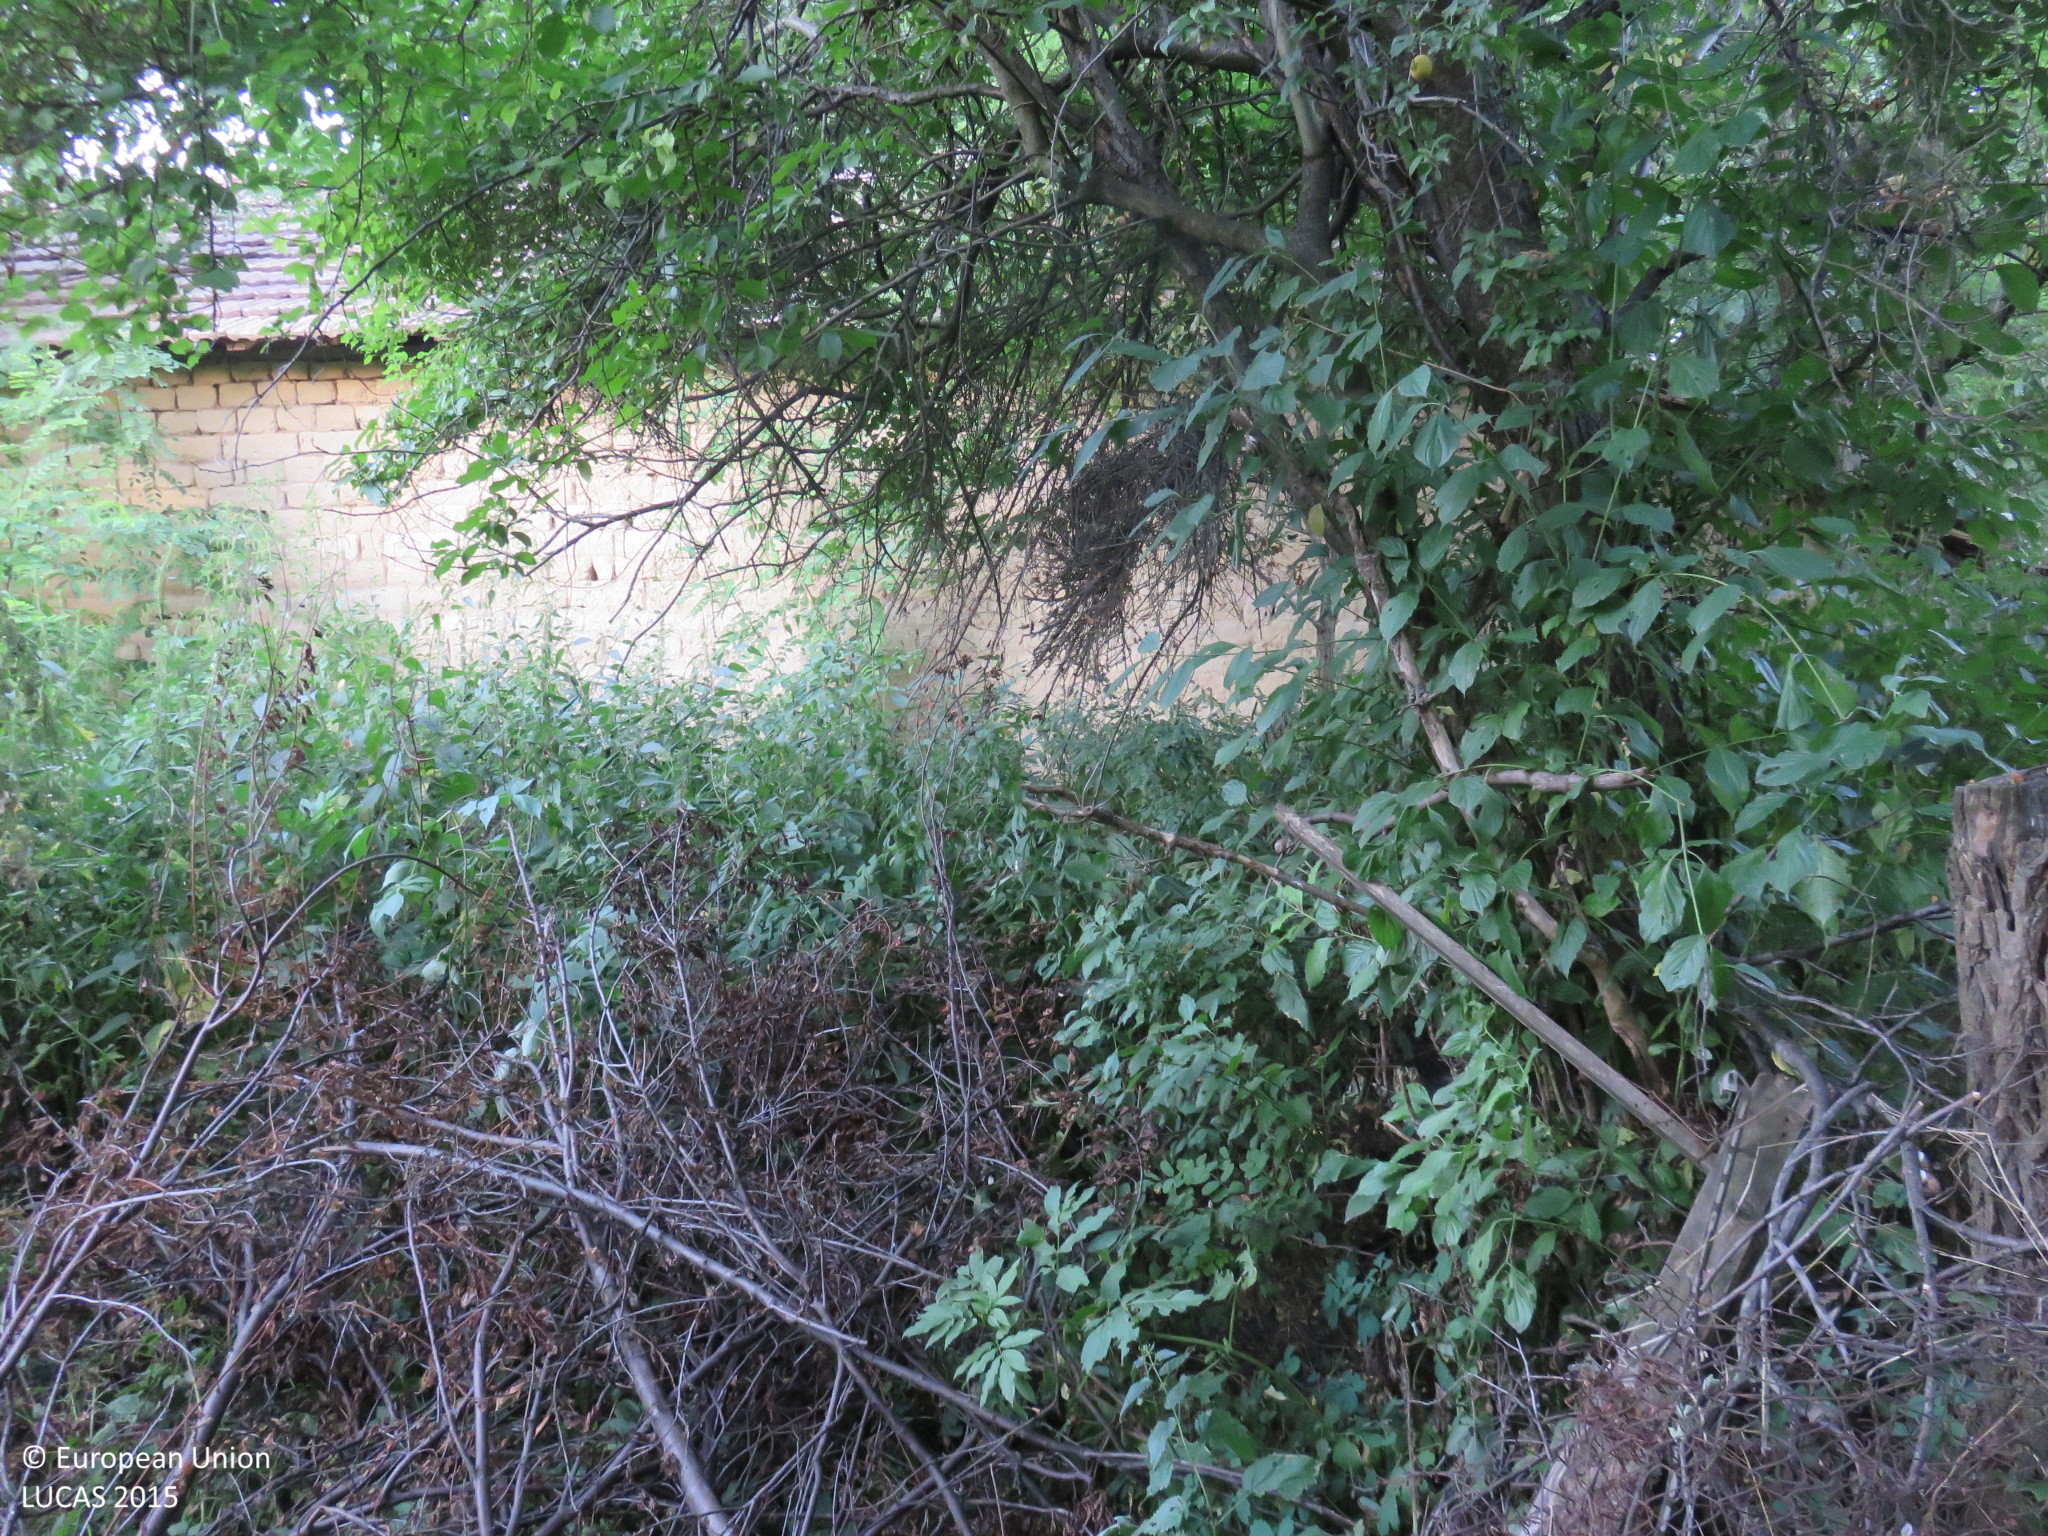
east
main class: Woodland
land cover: Broadleaved woodland
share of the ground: 25 - 50 %
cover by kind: herbaceous plants 60 %, broadleaved forest trees 35 %, shrubs 5 %
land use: Residential
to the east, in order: Broadleaved woodland; Artificial constructions in urban areas; Broadleaved woodland; Grassland without tree/shrub cover
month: July
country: BG
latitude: 43.1308
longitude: 25.2038
